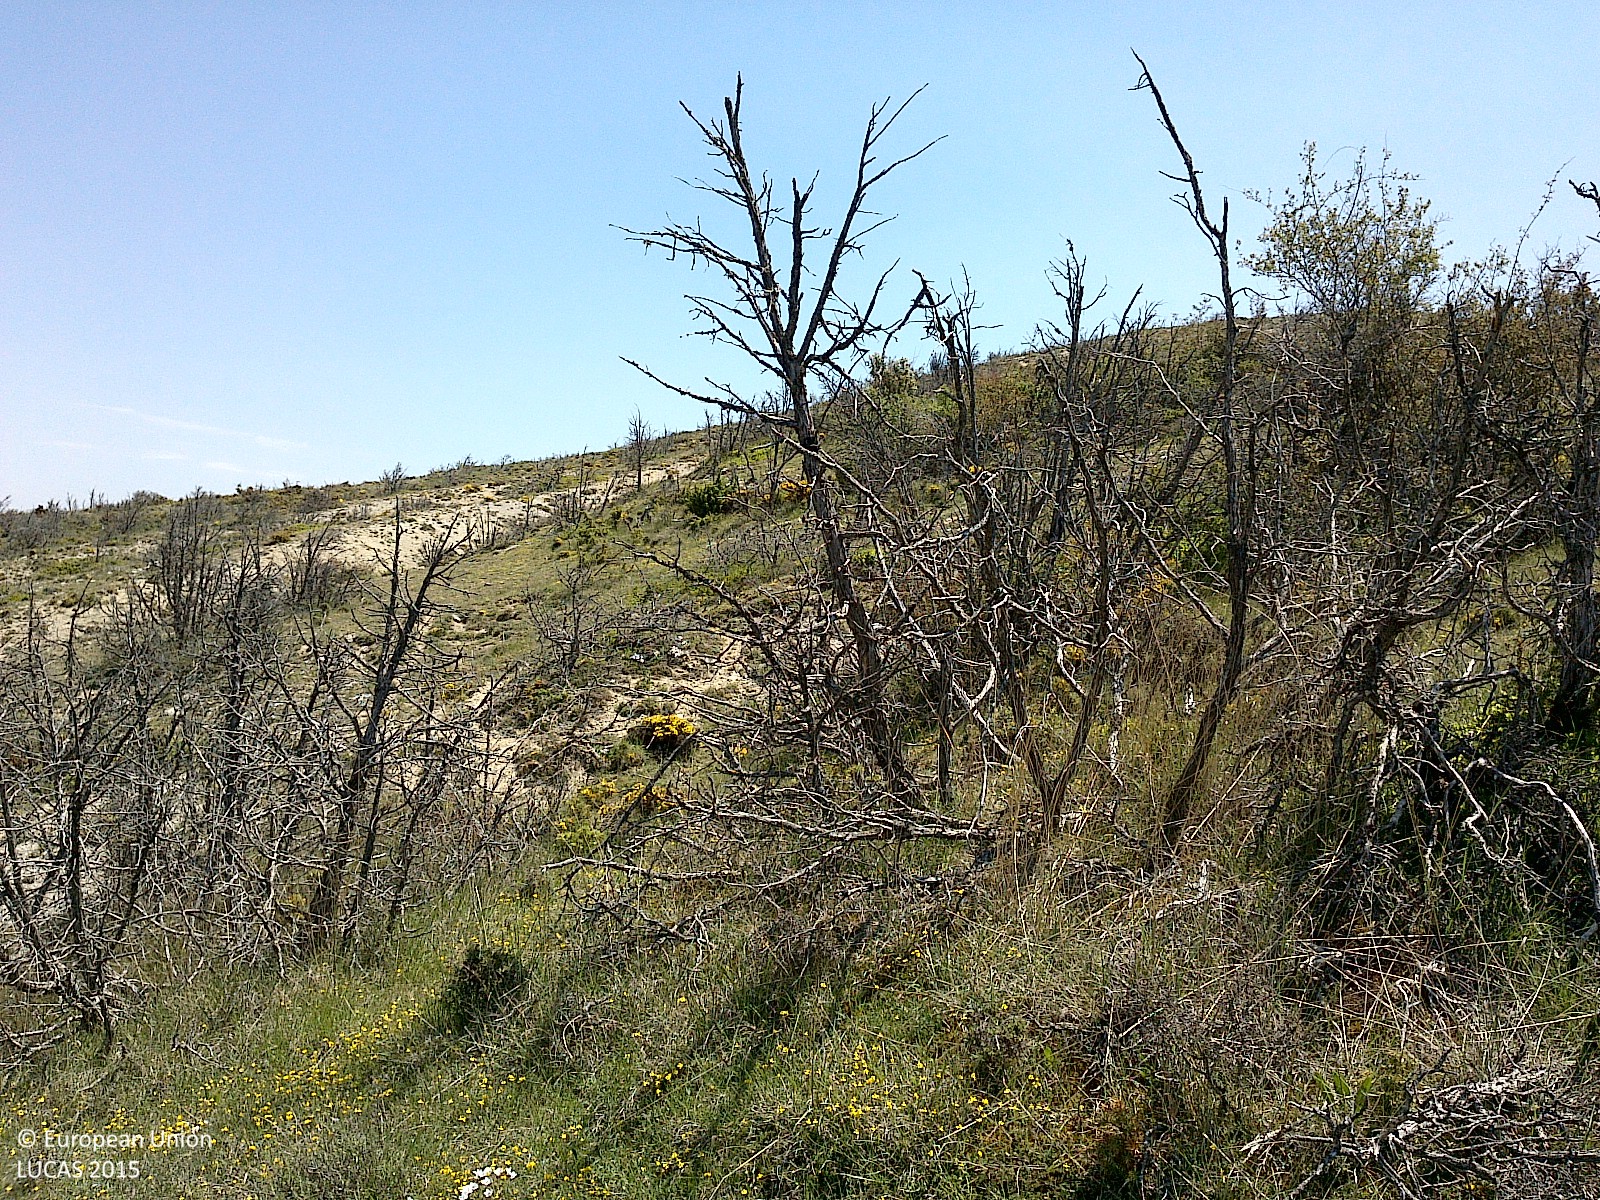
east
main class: Shrubland
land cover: Shrubland with sparse tree cover
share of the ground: 50 - 75 %
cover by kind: shrubs 55 %, herbaceous plants 20 %, consolidated bare surface 20 %, coniferous forest trees 5 %
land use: Semi-natural and natural areas not in use
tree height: < 5 m
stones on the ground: < 10 %
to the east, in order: Shrubland with sparse tree cover; Grassland without tree/shrub cover; Shrubland with sparse tree cover; Grassland with sparse tree/shrub cover; Shrubland with sparse tree cover; Grassland with sparse tree/shrub cover; Shrubland with sparse tree cover
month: May
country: ES
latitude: 41.8512
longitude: -2.2620
